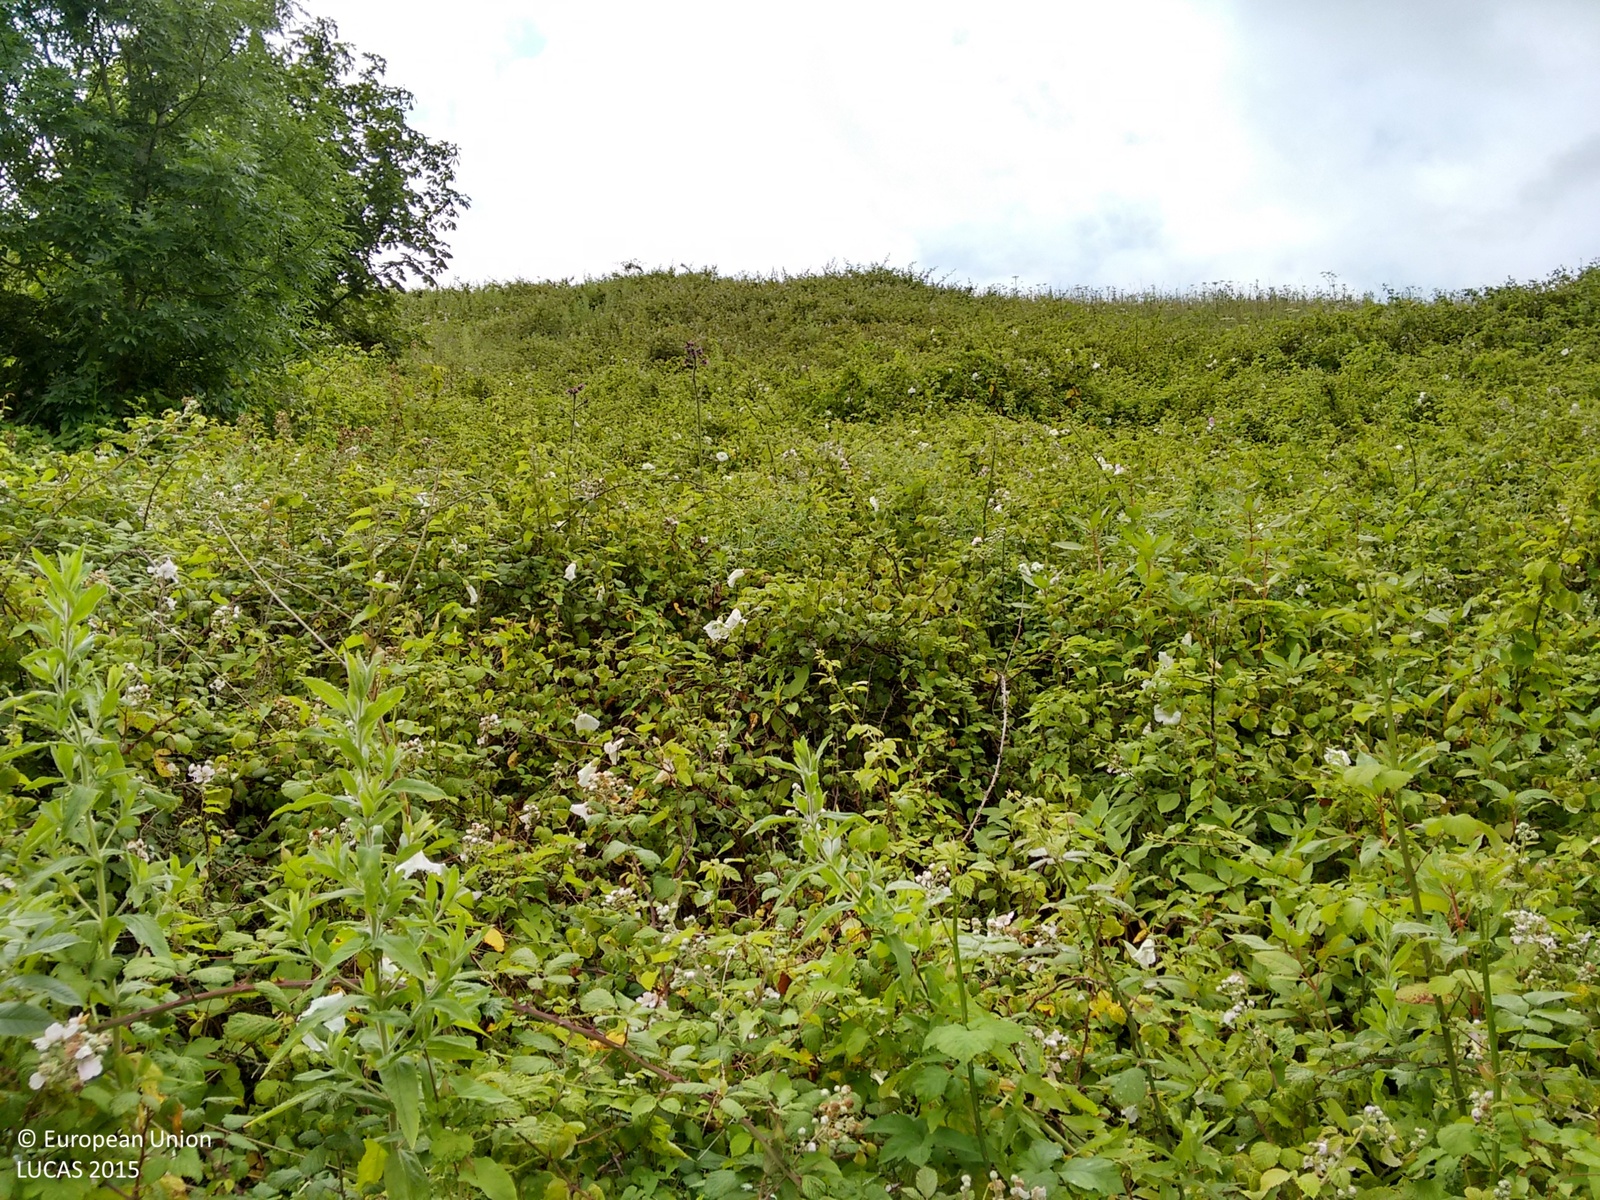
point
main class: Shrubland
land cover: Shrubland with sparse tree cover
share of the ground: > 75 %
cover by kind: shrubs 95 %, broadleaved forest trees 5 %
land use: Semi-natural and natural areas not in use
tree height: < 5 m
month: July
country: GB
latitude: 51.5182
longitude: -3.5896
